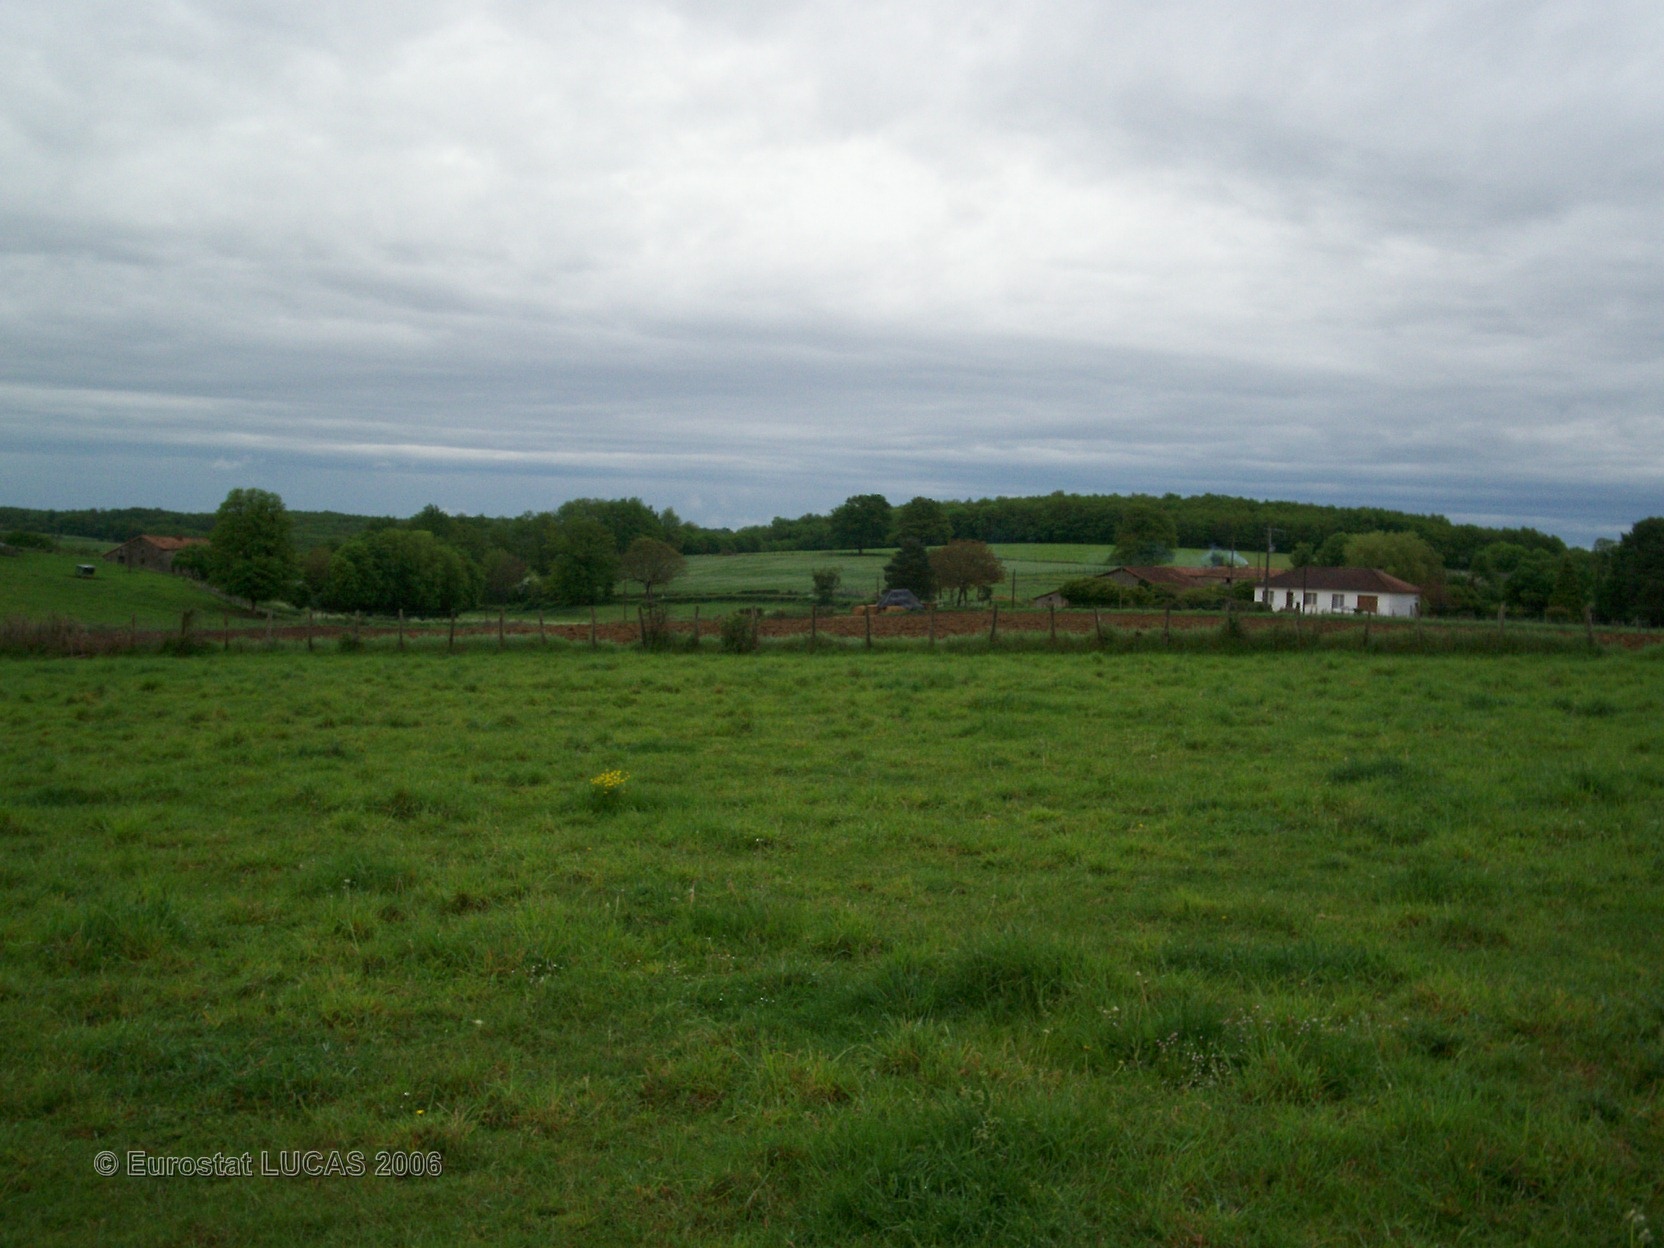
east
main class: Grassland
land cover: Grassland without tree/shrub cover
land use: Agriculture (excluding fallow land and kitchen gardens)
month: May
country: FR
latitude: 46.0485
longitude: 0.4334
